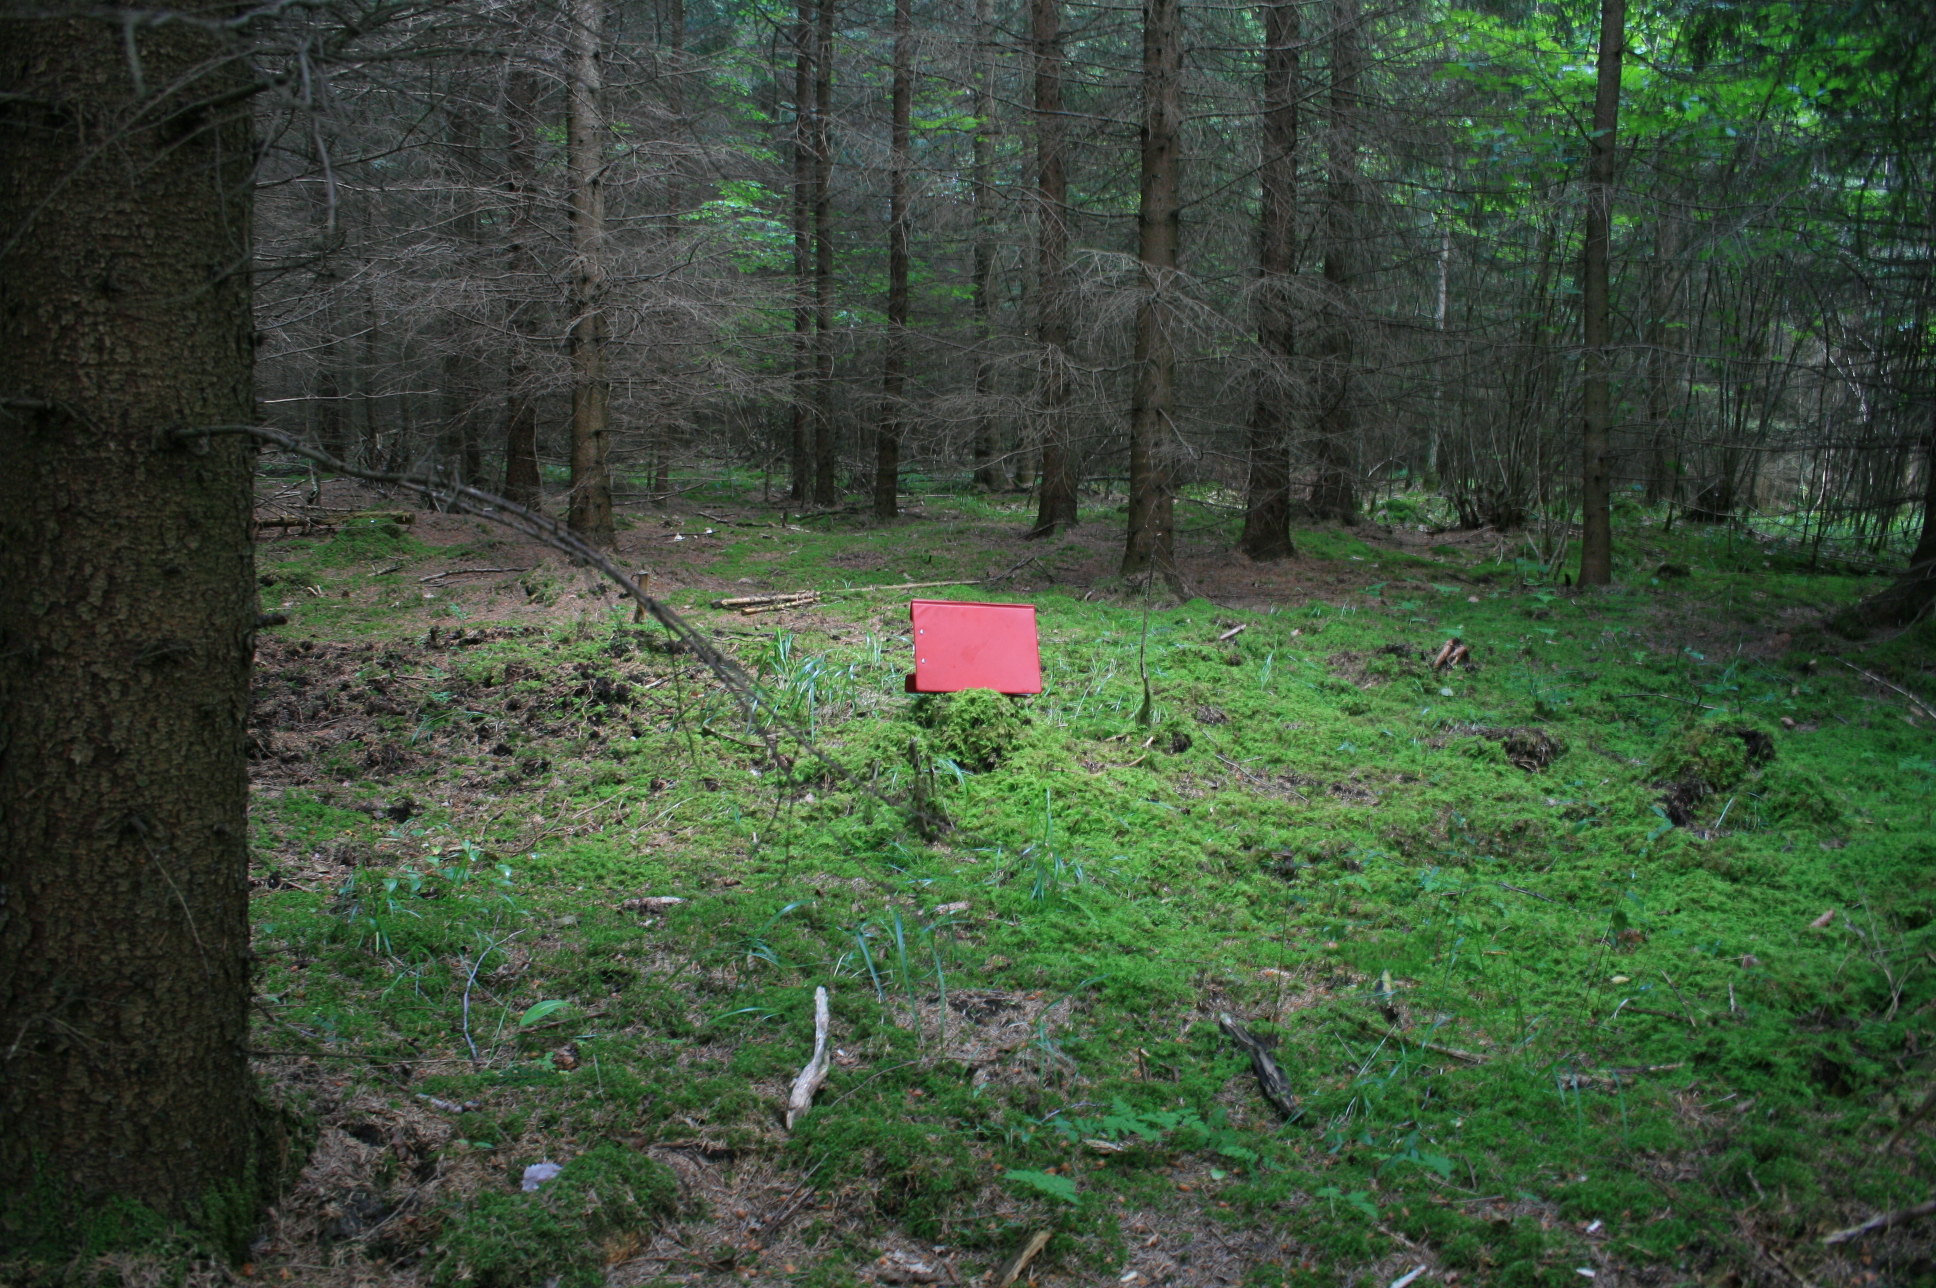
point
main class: Woodland
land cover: Spruce dominated coniferous woodland
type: hemiboreal forest and nemoral coniferous forest and mixed broadleaved-coniferous forest
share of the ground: > 75 %
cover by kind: coniferous forest trees 95 %, lichens and mosses 5 %
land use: Forestry
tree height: > 5 m
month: July
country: LT
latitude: 55.4208
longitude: 21.8209
